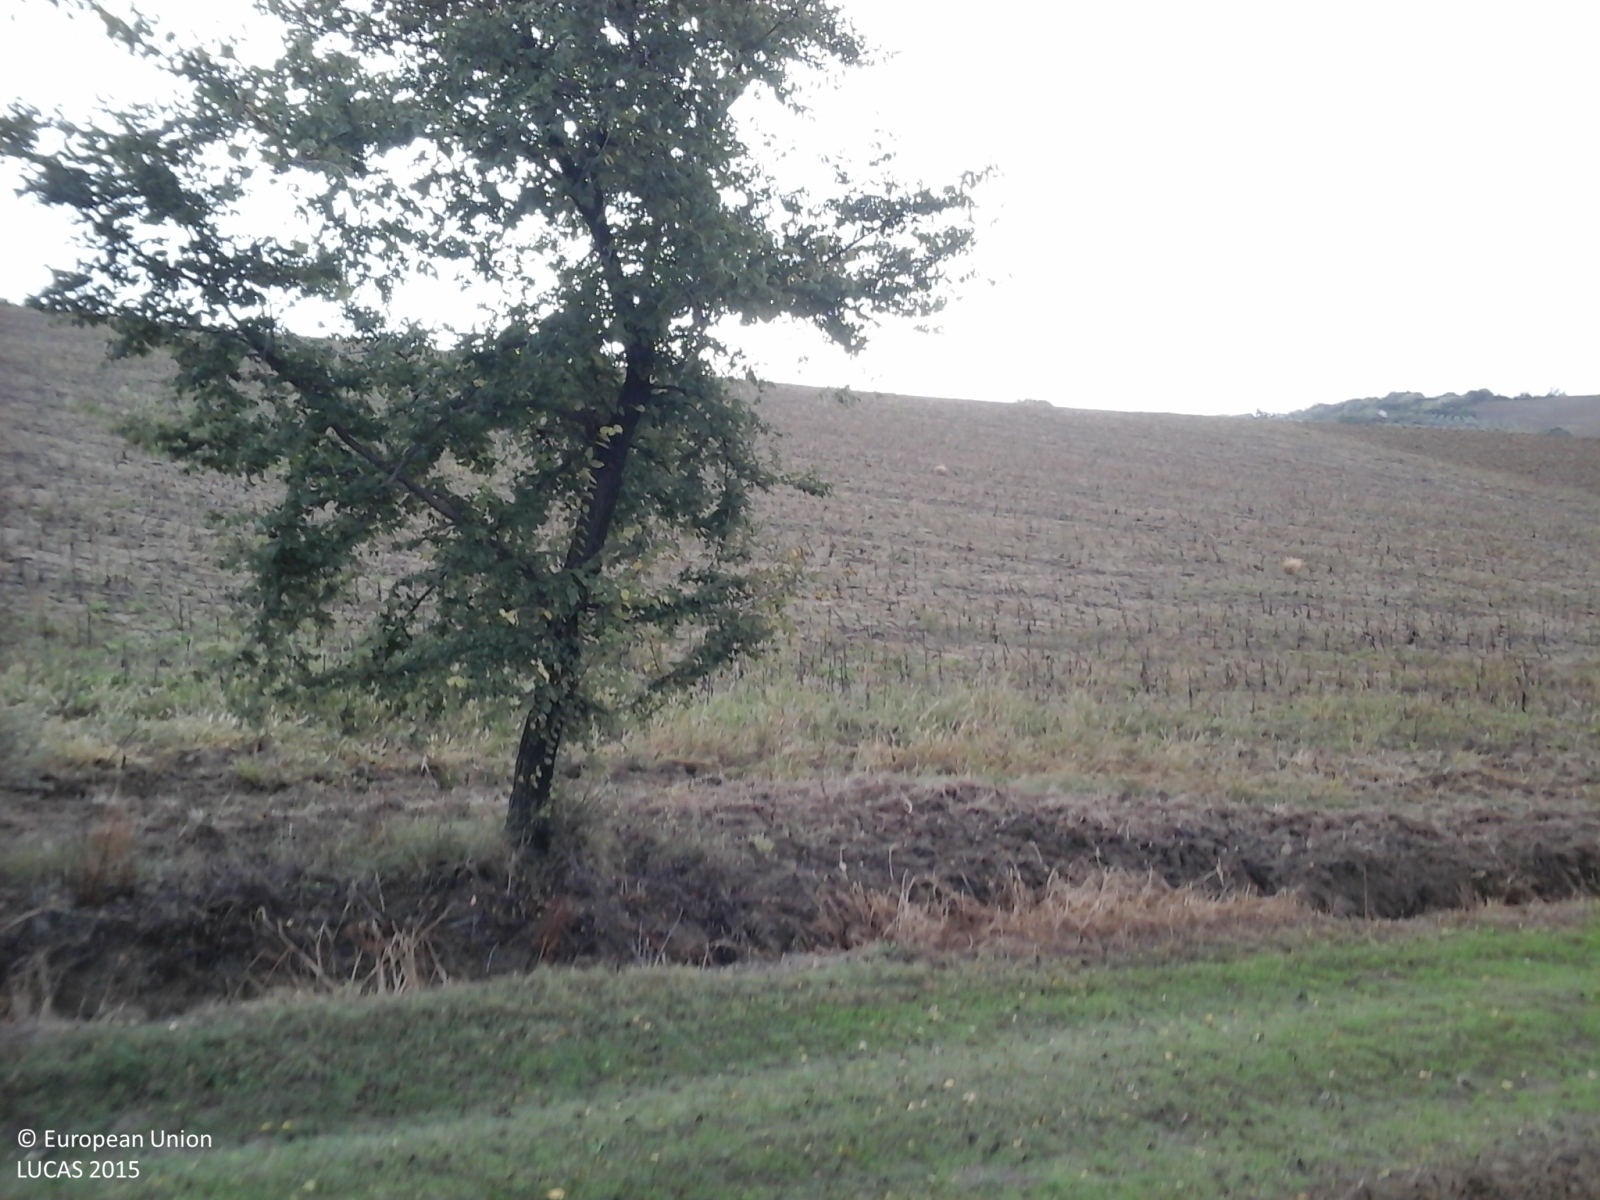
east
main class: Cropland
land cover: Sunflower
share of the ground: < 10 %
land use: Agriculture (excluding fallow land and kitchen gardens)
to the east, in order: Sunflower; Tracks; Ditches and canals; Abandoned hedges; Sunflower
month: October
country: IT
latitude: 43.6865
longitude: 13.2302
